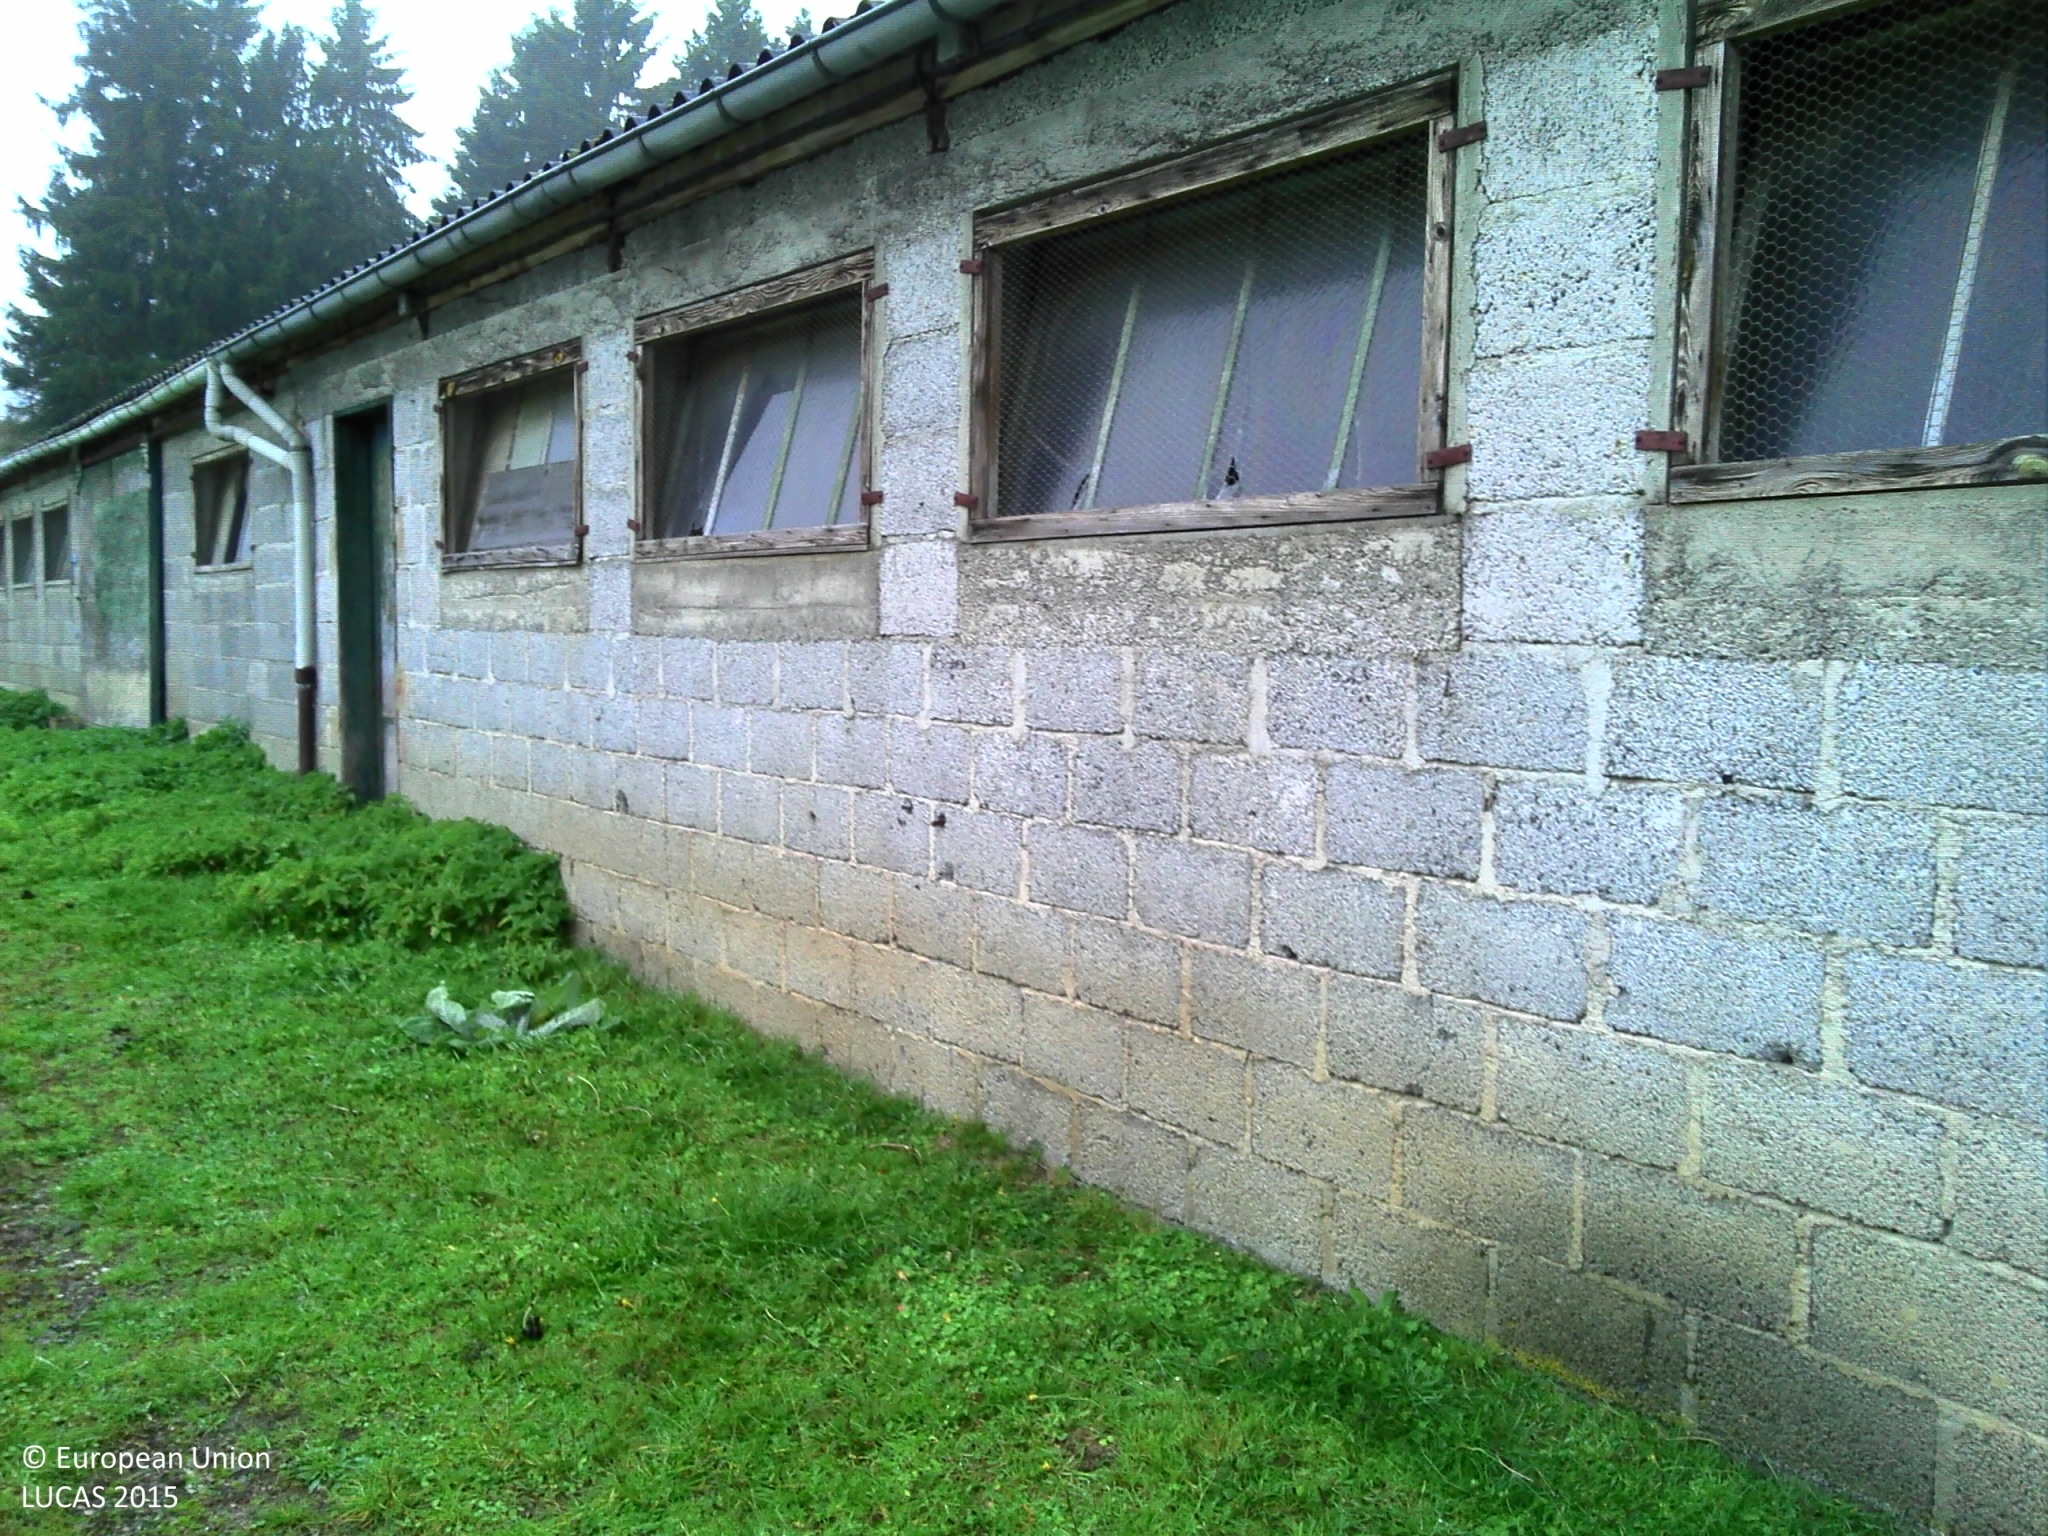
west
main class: Grassland
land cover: Grassland without tree/shrub cover
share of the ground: > 75 %
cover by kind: herbaceous plants 85 %, unconsolidated bare surface 15 %
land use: Agriculture (excluding fallow land and kitchen gardens)
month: October
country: FR
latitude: 45.7477
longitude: 2.8134
